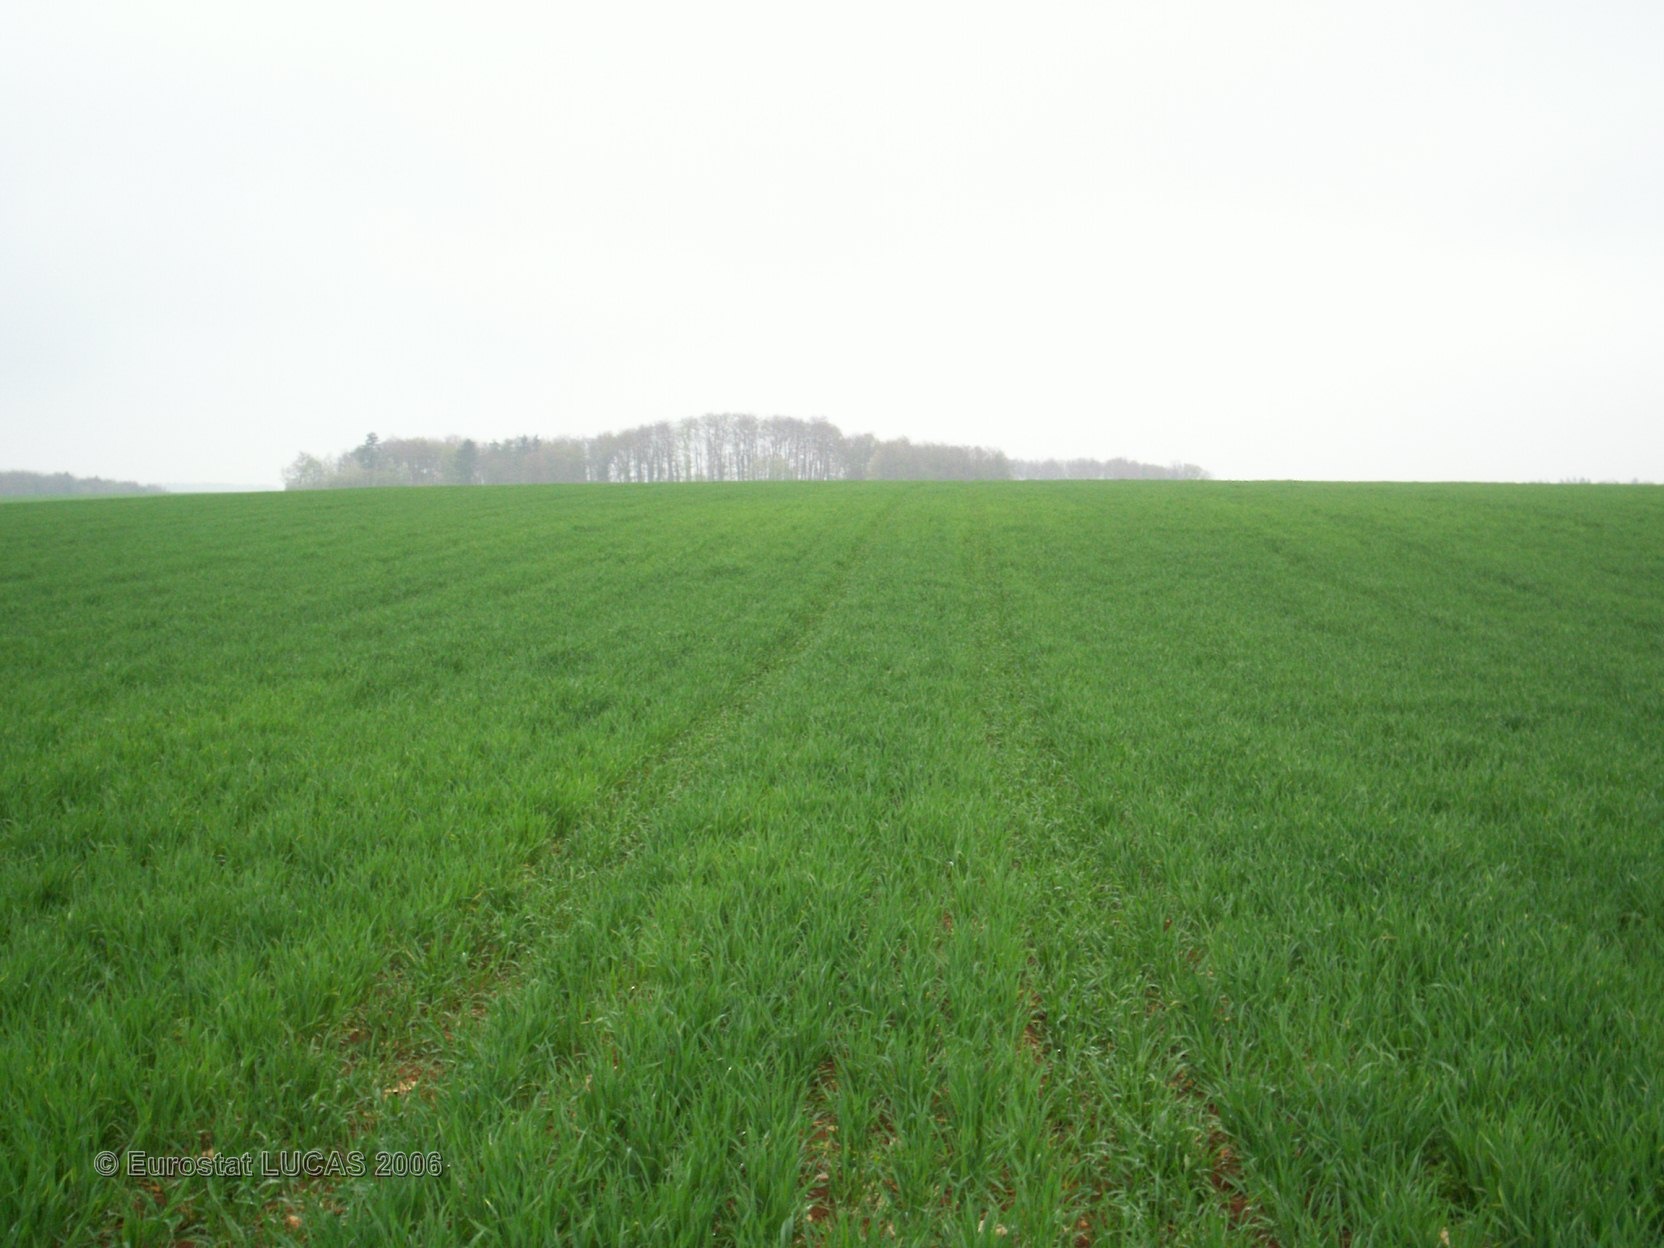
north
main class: Cropland
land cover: Common wheat
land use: Agriculture (excluding fallow land and kitchen gardens)
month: April
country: FR
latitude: 47.7803
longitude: 4.5132
